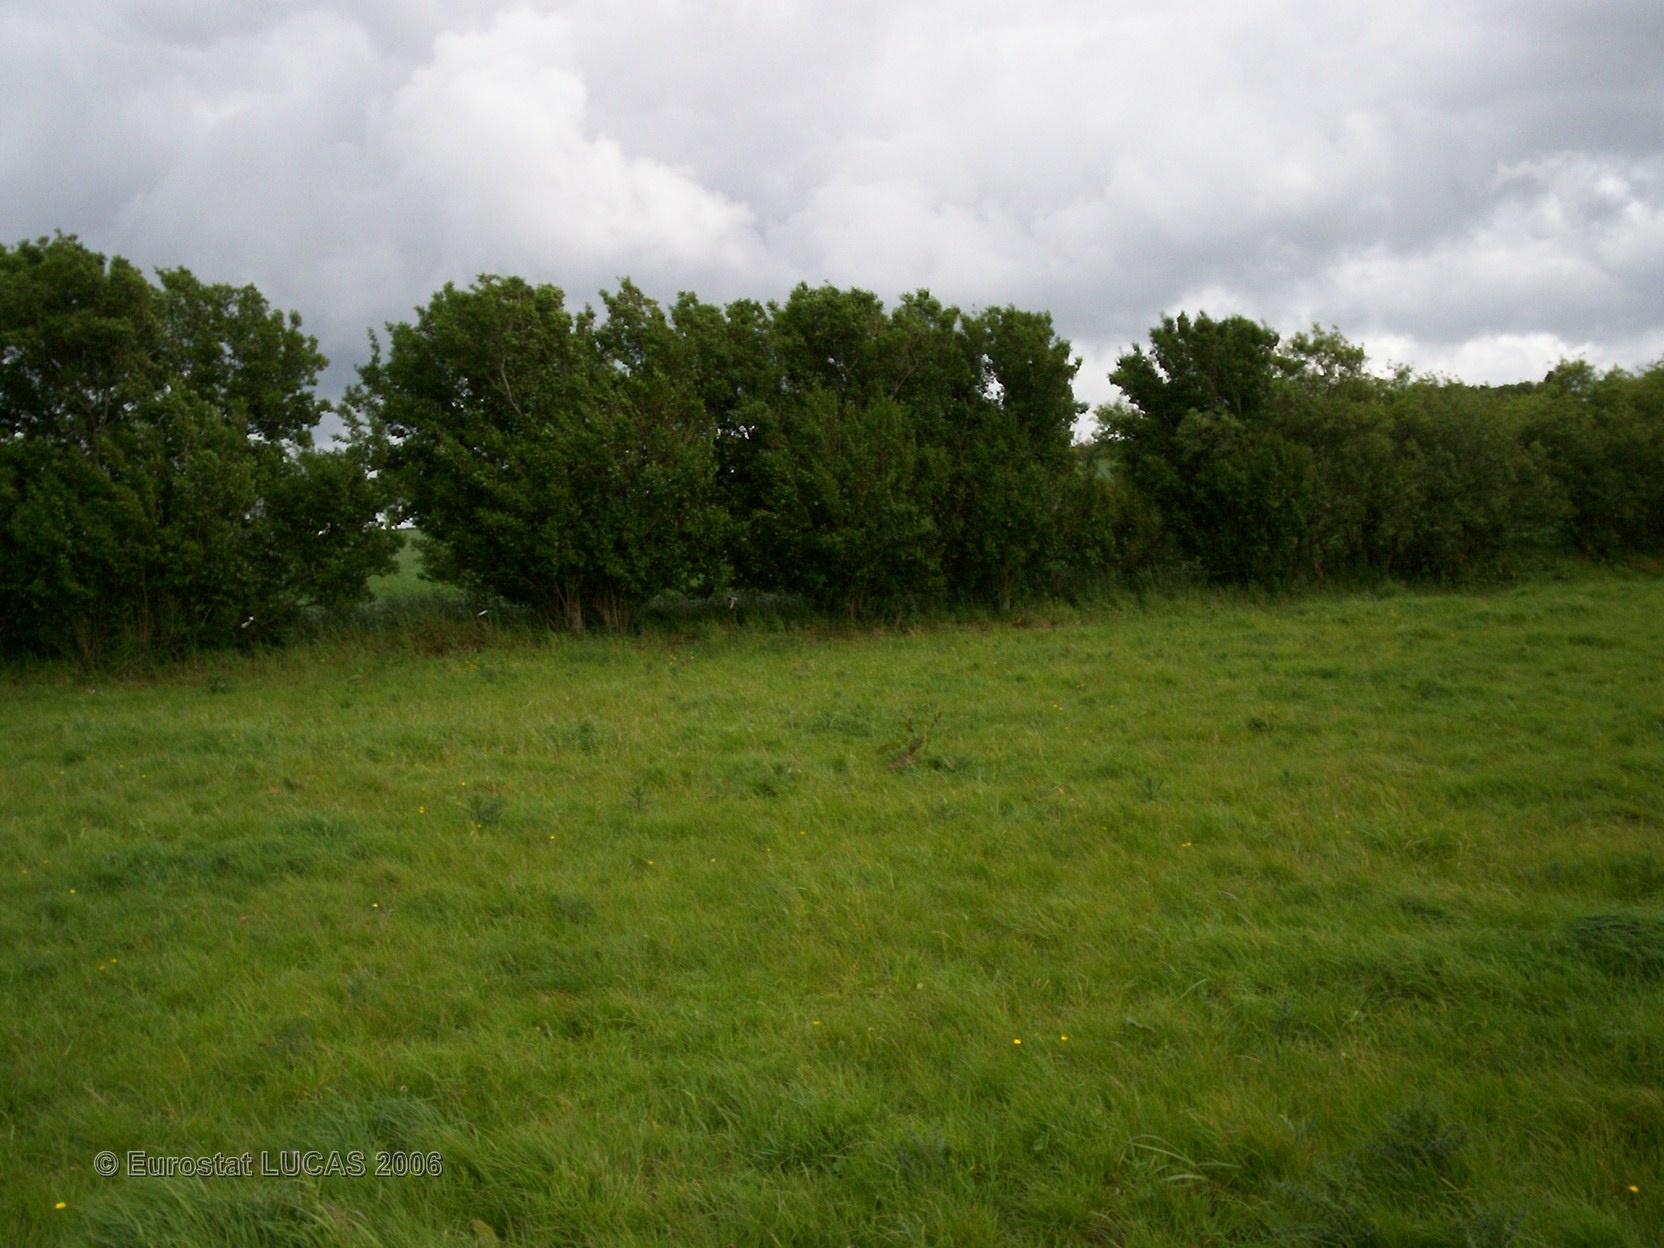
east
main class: Grassland
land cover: Grassland without tree/shrub cover
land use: Agriculture (excluding fallow land and kitchen gardens)
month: May
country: FR
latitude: 48.1181
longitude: -3.9352
